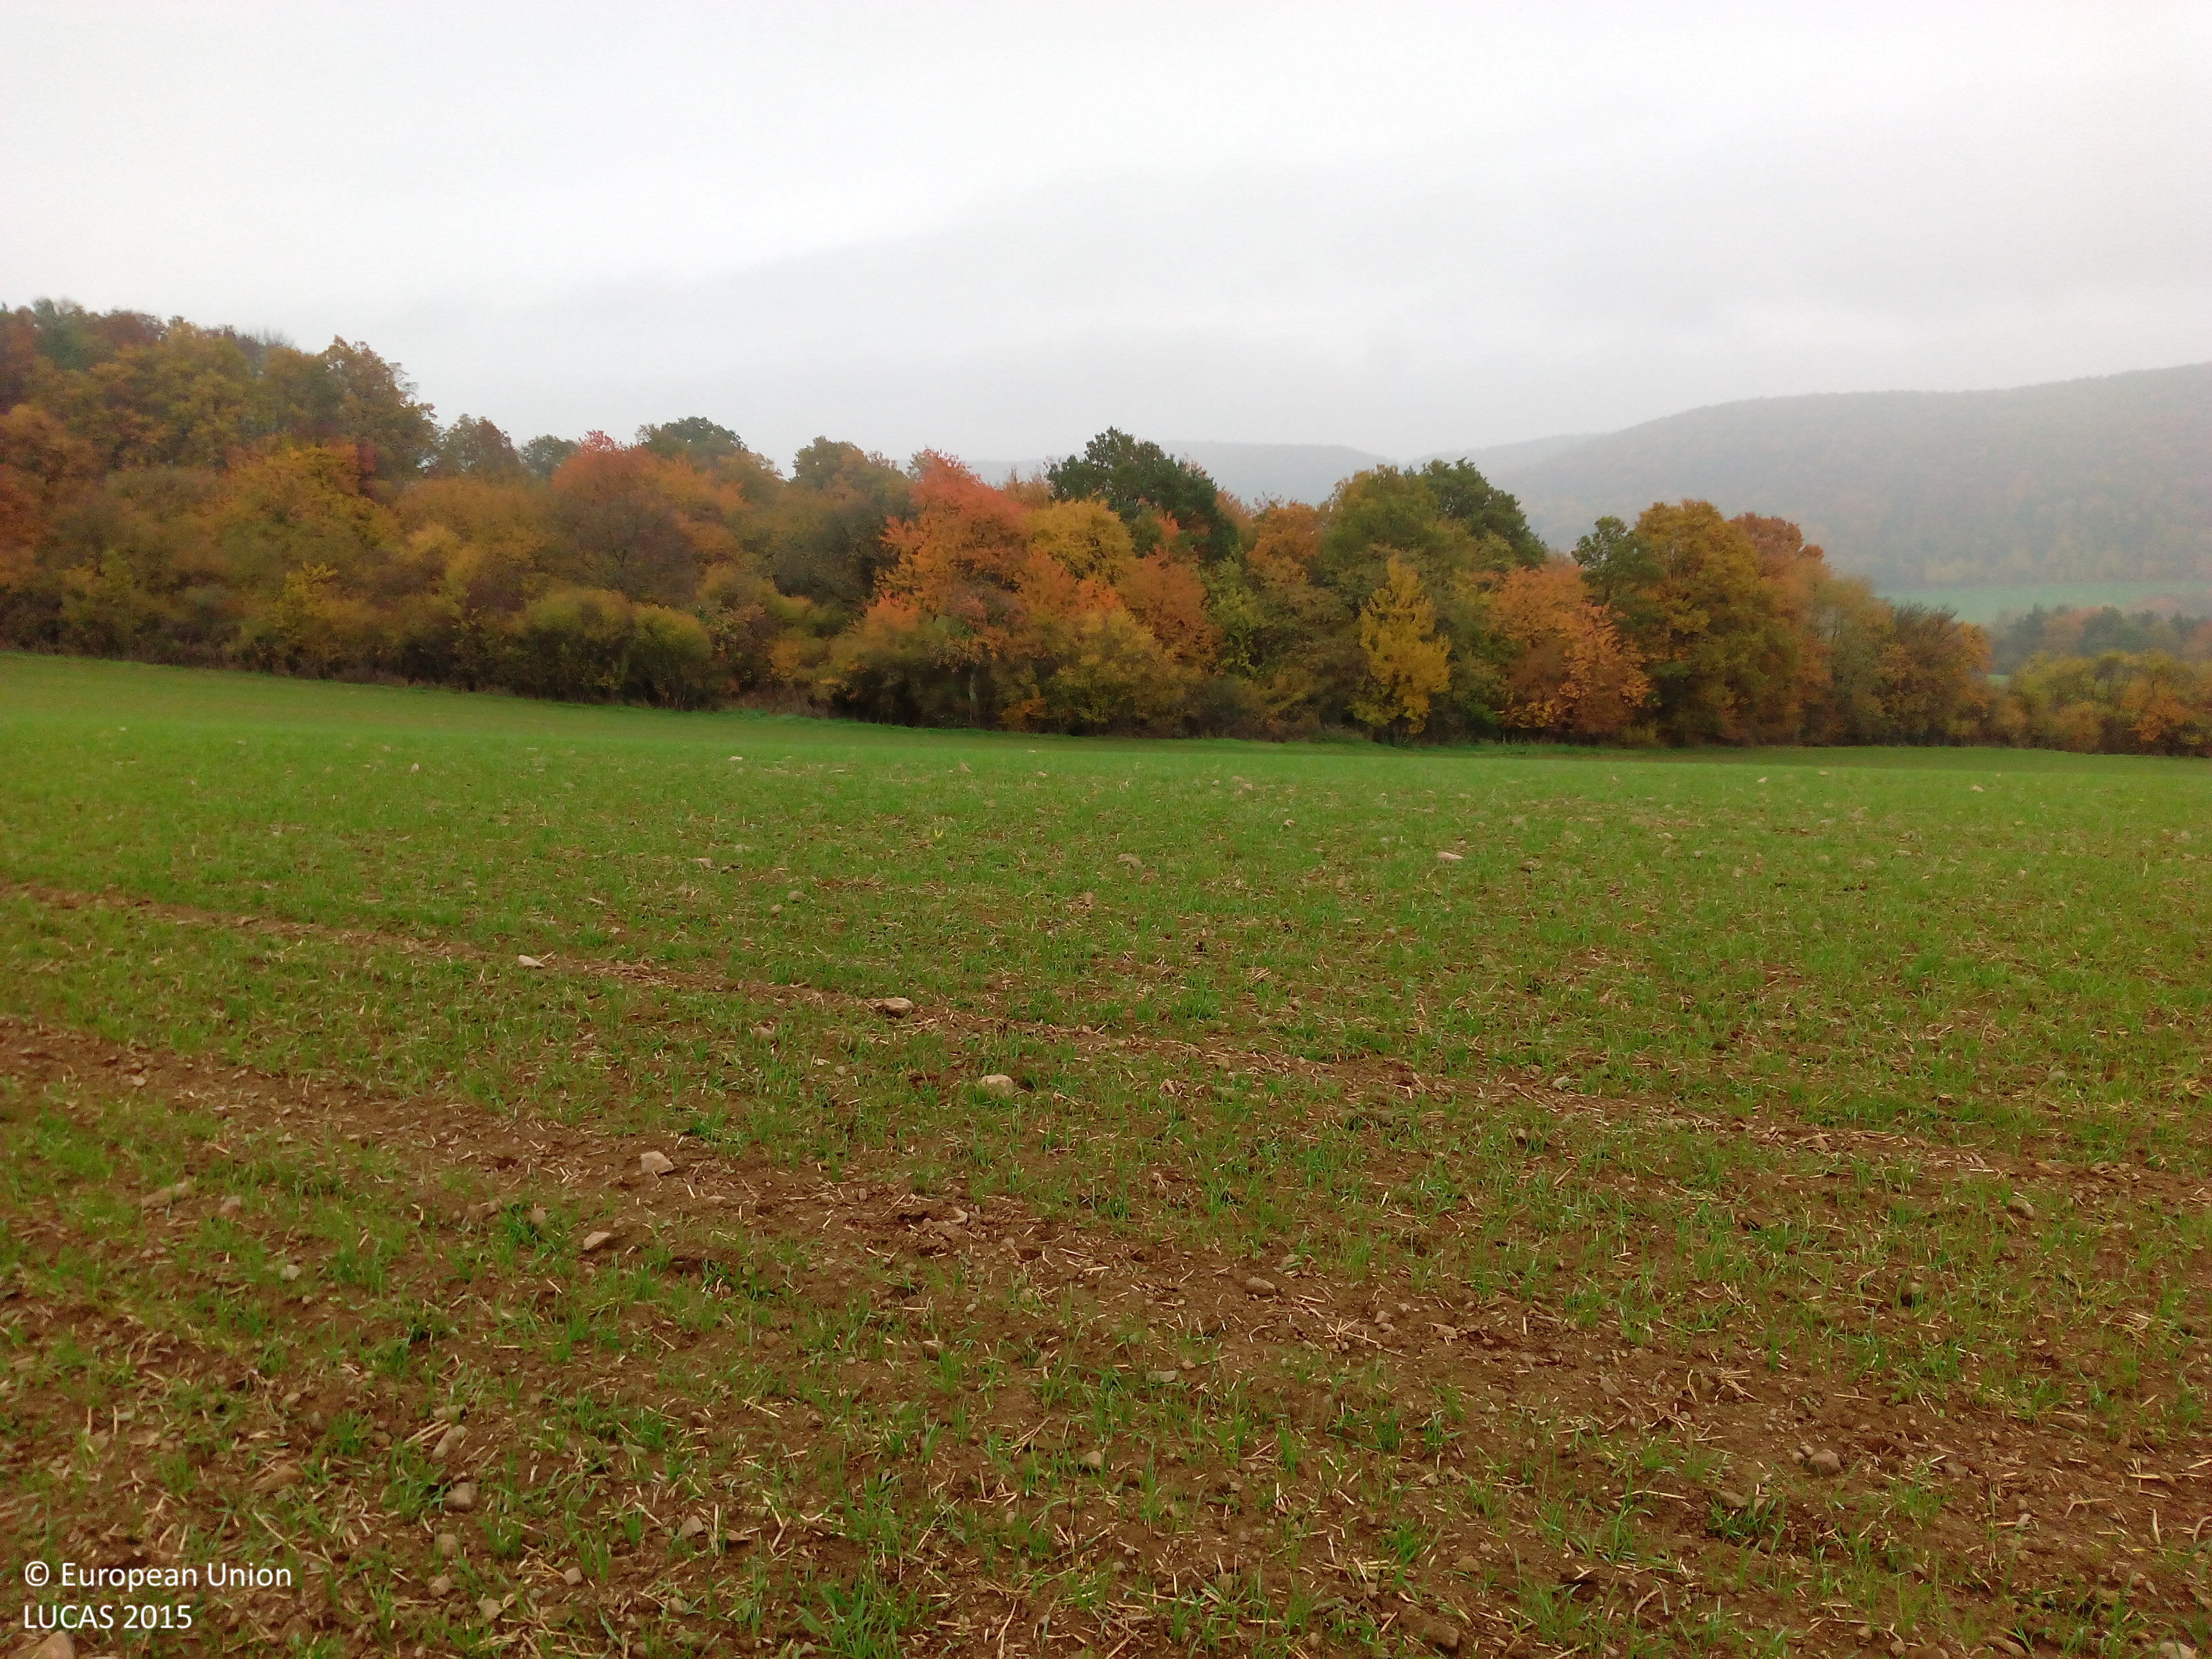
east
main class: Cropland
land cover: Common wheat
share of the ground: < 10 %
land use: Agriculture (excluding fallow land and kitchen gardens)
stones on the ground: 10 - 25 %
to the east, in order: Common wheat; Broadleaved woodland; Grassland without tree/shrub cover; Broadleaved woodland; Common wheat
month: October
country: DE
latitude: 50.1662
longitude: 9.9020
